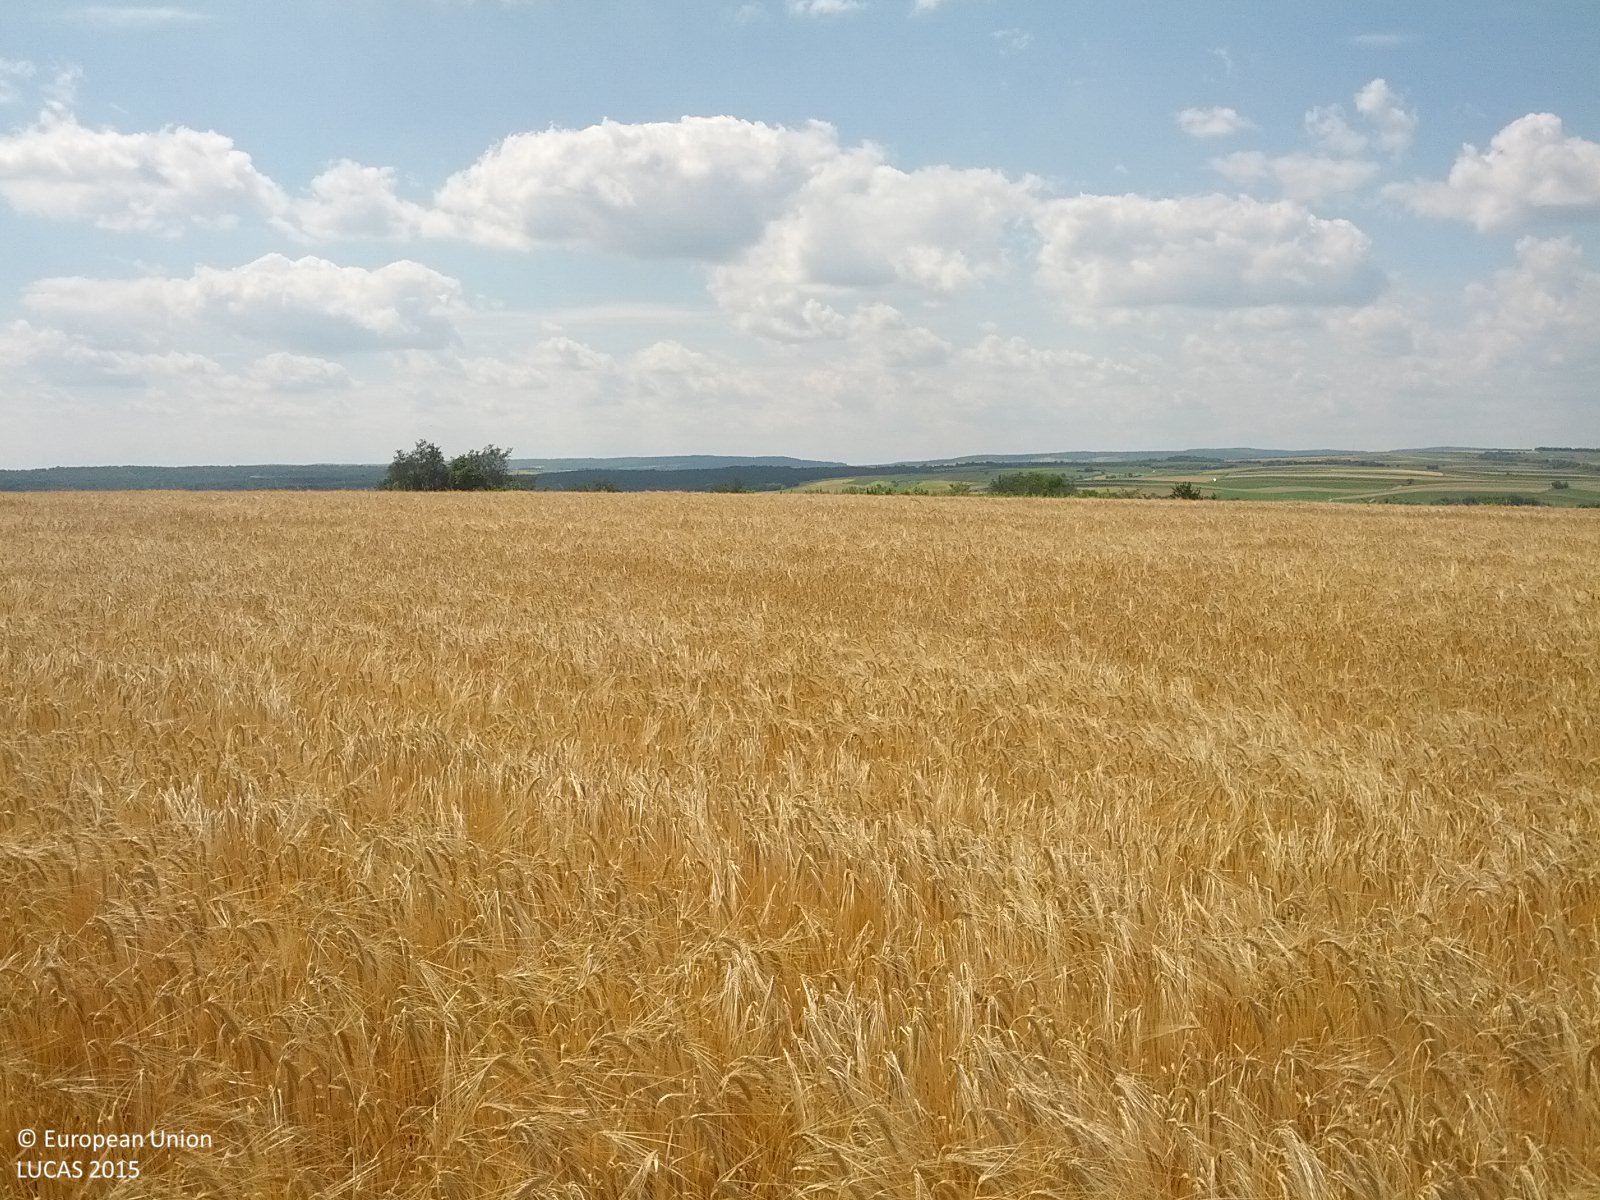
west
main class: Cropland
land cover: Barley
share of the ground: > 75 %
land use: Agriculture (excluding fallow land and kitchen gardens)
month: June
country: AT
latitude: 48.4399
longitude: 16.6166
